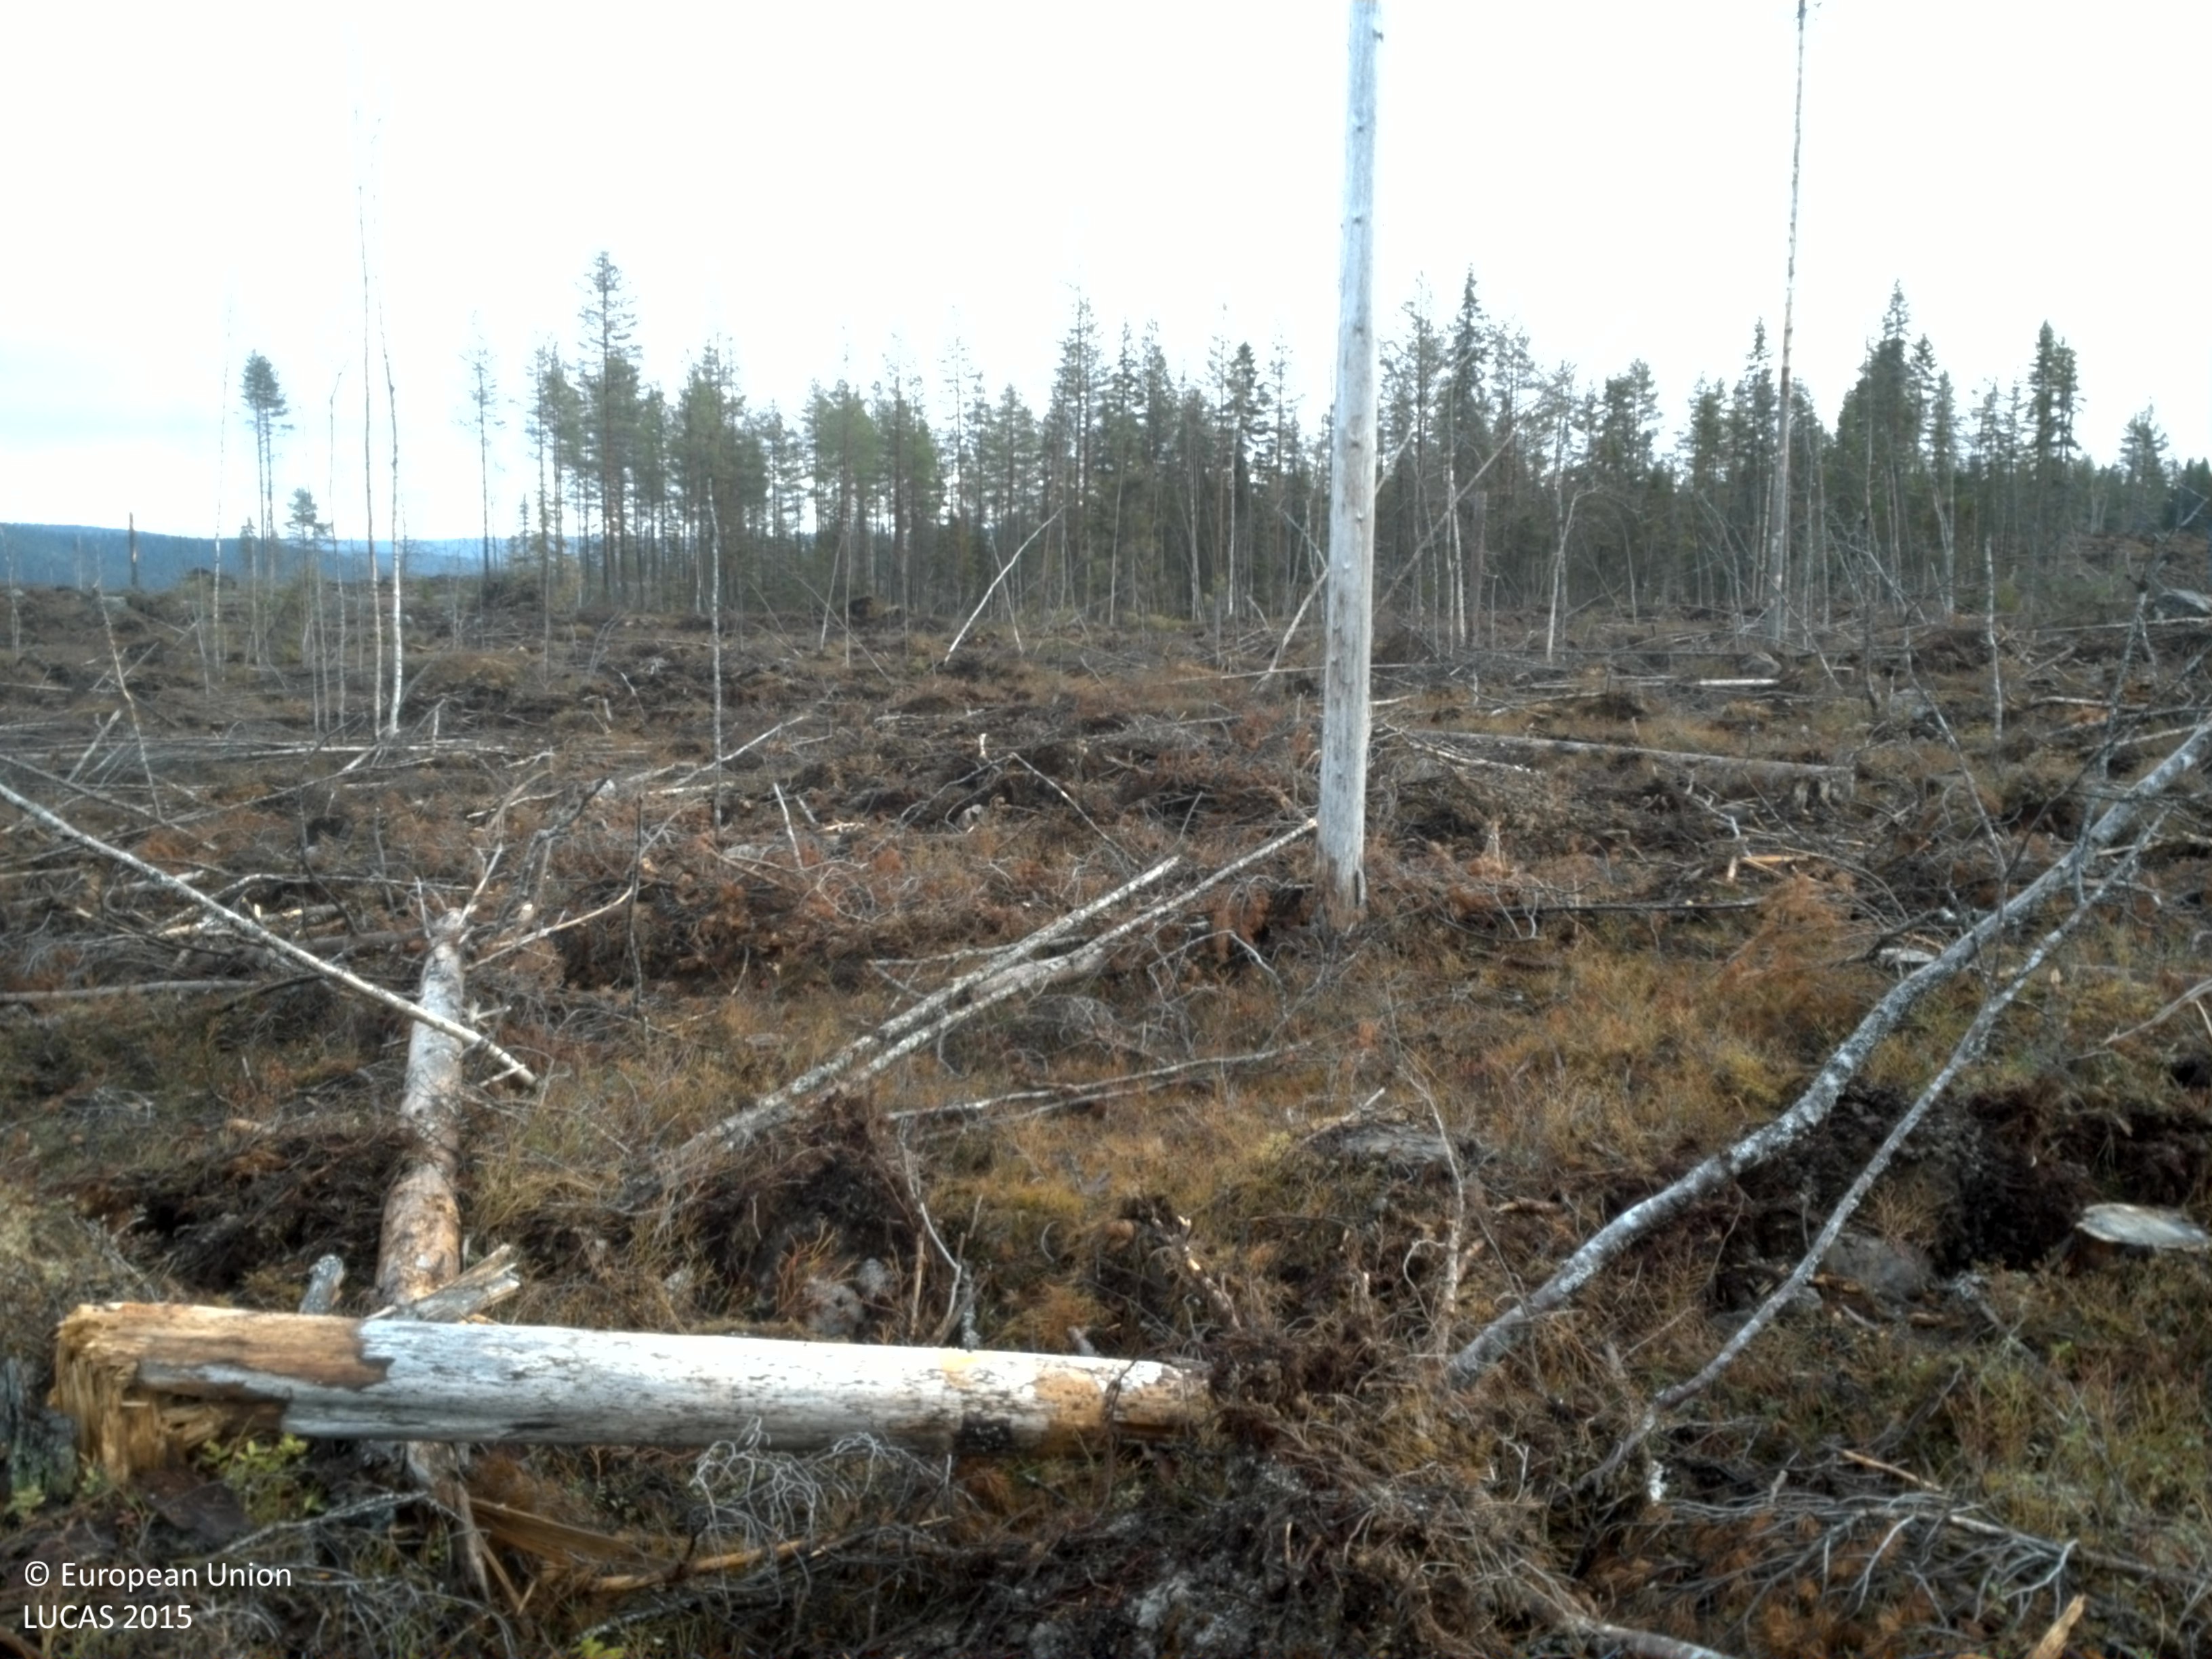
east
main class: Shrubland
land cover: Shrubland with sparse tree cover
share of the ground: 25 - 50 %
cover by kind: shrubs 35 %, unconsolidated bare surface 15 %, herbaceous plants 10 %, lichens and mosses 10 %, broadleaved forest trees 5 %, consolidated bare surface 5 %
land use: Forestry
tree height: < 5 m
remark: Clear cut
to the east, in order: Shrubland with sparse tree cover; Other coniferous woodland; Pine dominated coniferous woodland; Shrubland with sparse tree cover; Other bare soil; Paved roads, cycling and walking lanes; Spruce dominated mixed woodland; Other bare soil; Shrubland without tree cover
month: October
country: SE
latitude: 64.3995
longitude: 16.7509
